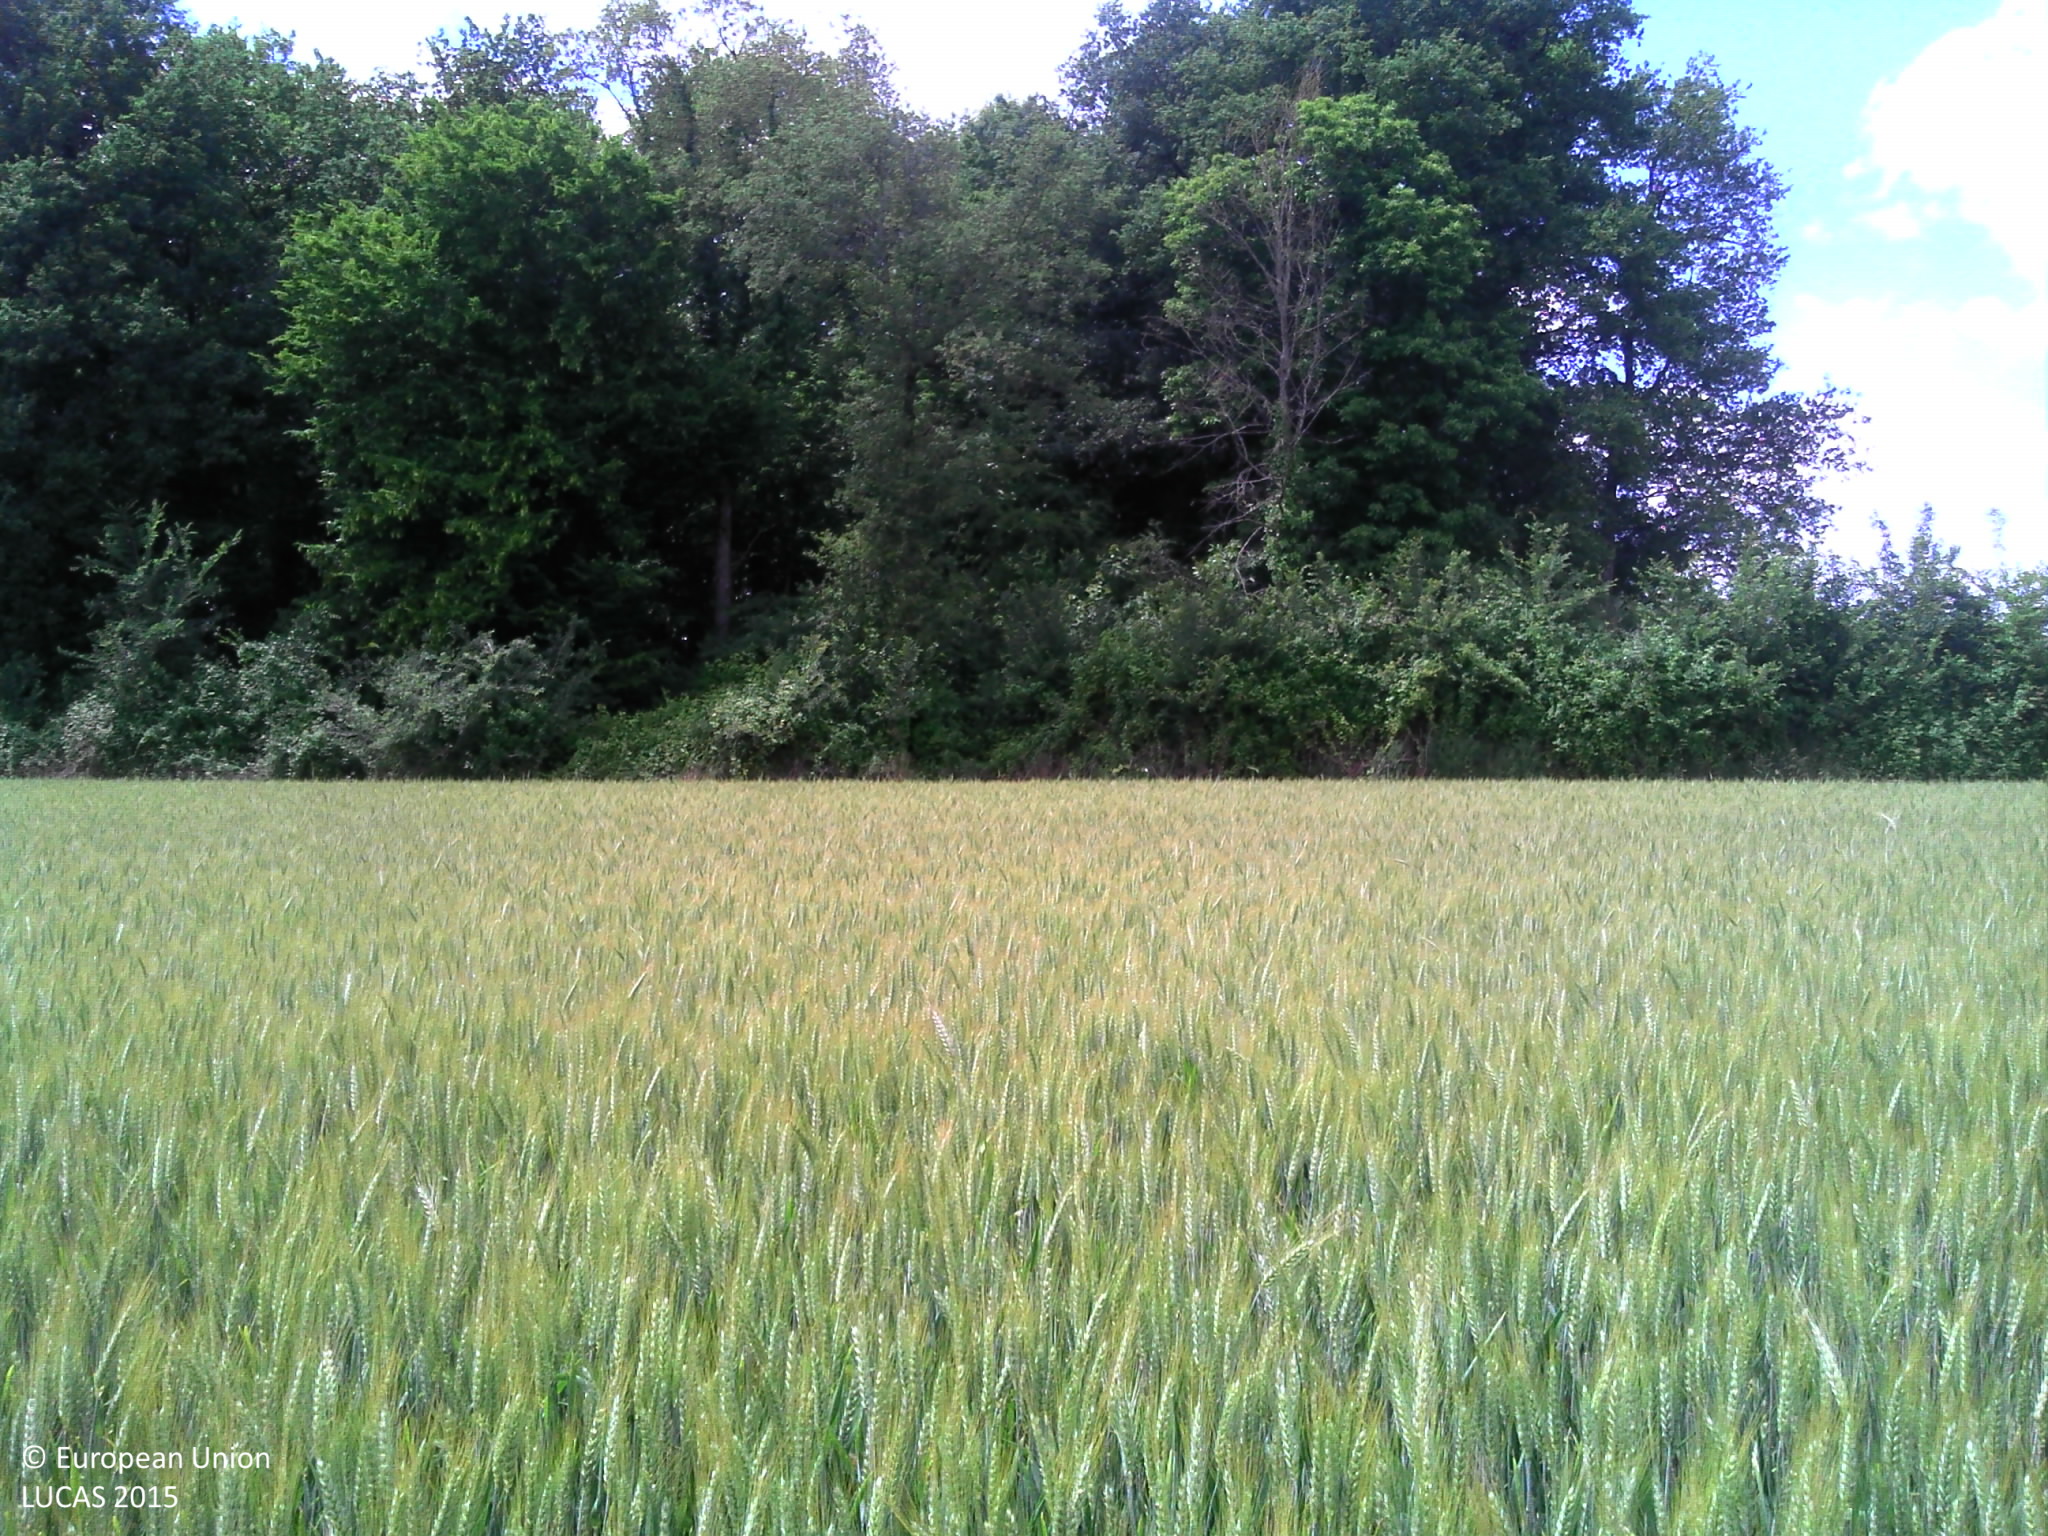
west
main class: Cropland
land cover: Durum wheat
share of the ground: > 75 %
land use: Agriculture (excluding fallow land and kitchen gardens)
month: June
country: FR
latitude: 47.2154
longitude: 1.1511
